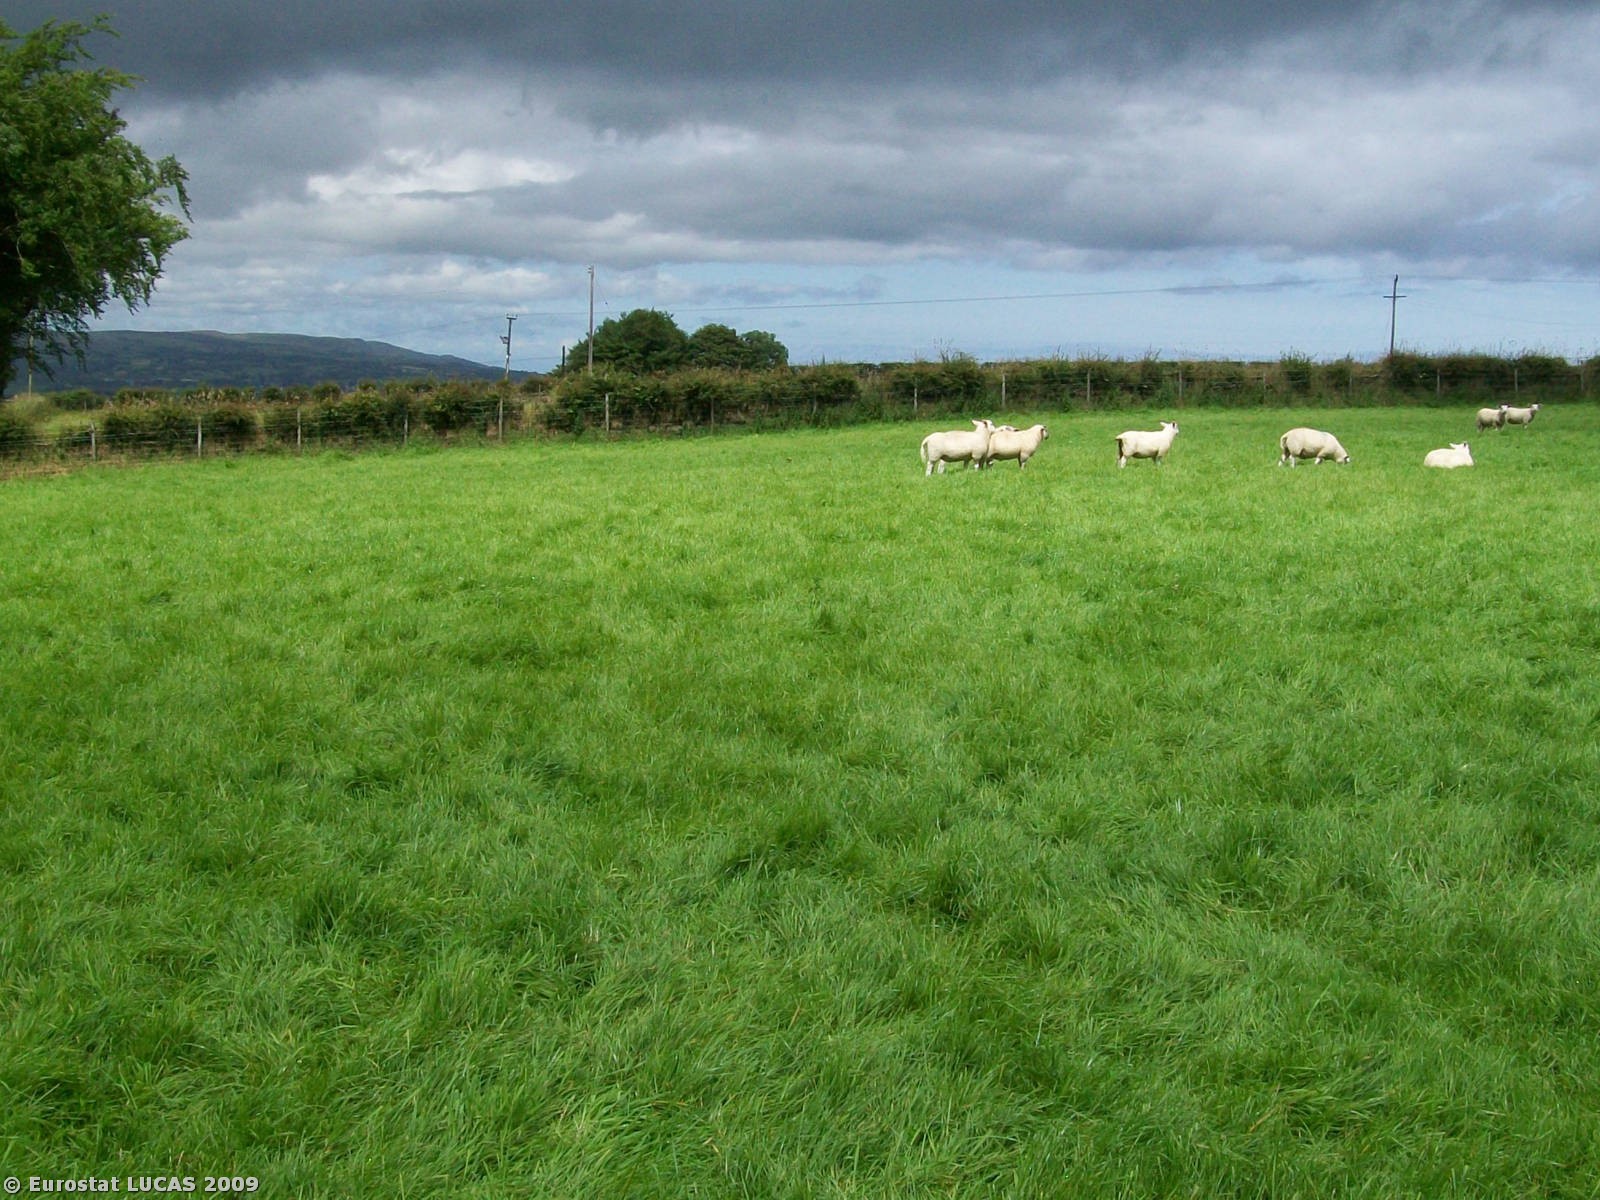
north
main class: Grassland
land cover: Grassland without tree/shrub cover
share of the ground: > 75 %
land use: Agriculture (excluding fallow land and kitchen gardens)
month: July
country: GB
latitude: 54.7707
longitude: -5.8514
